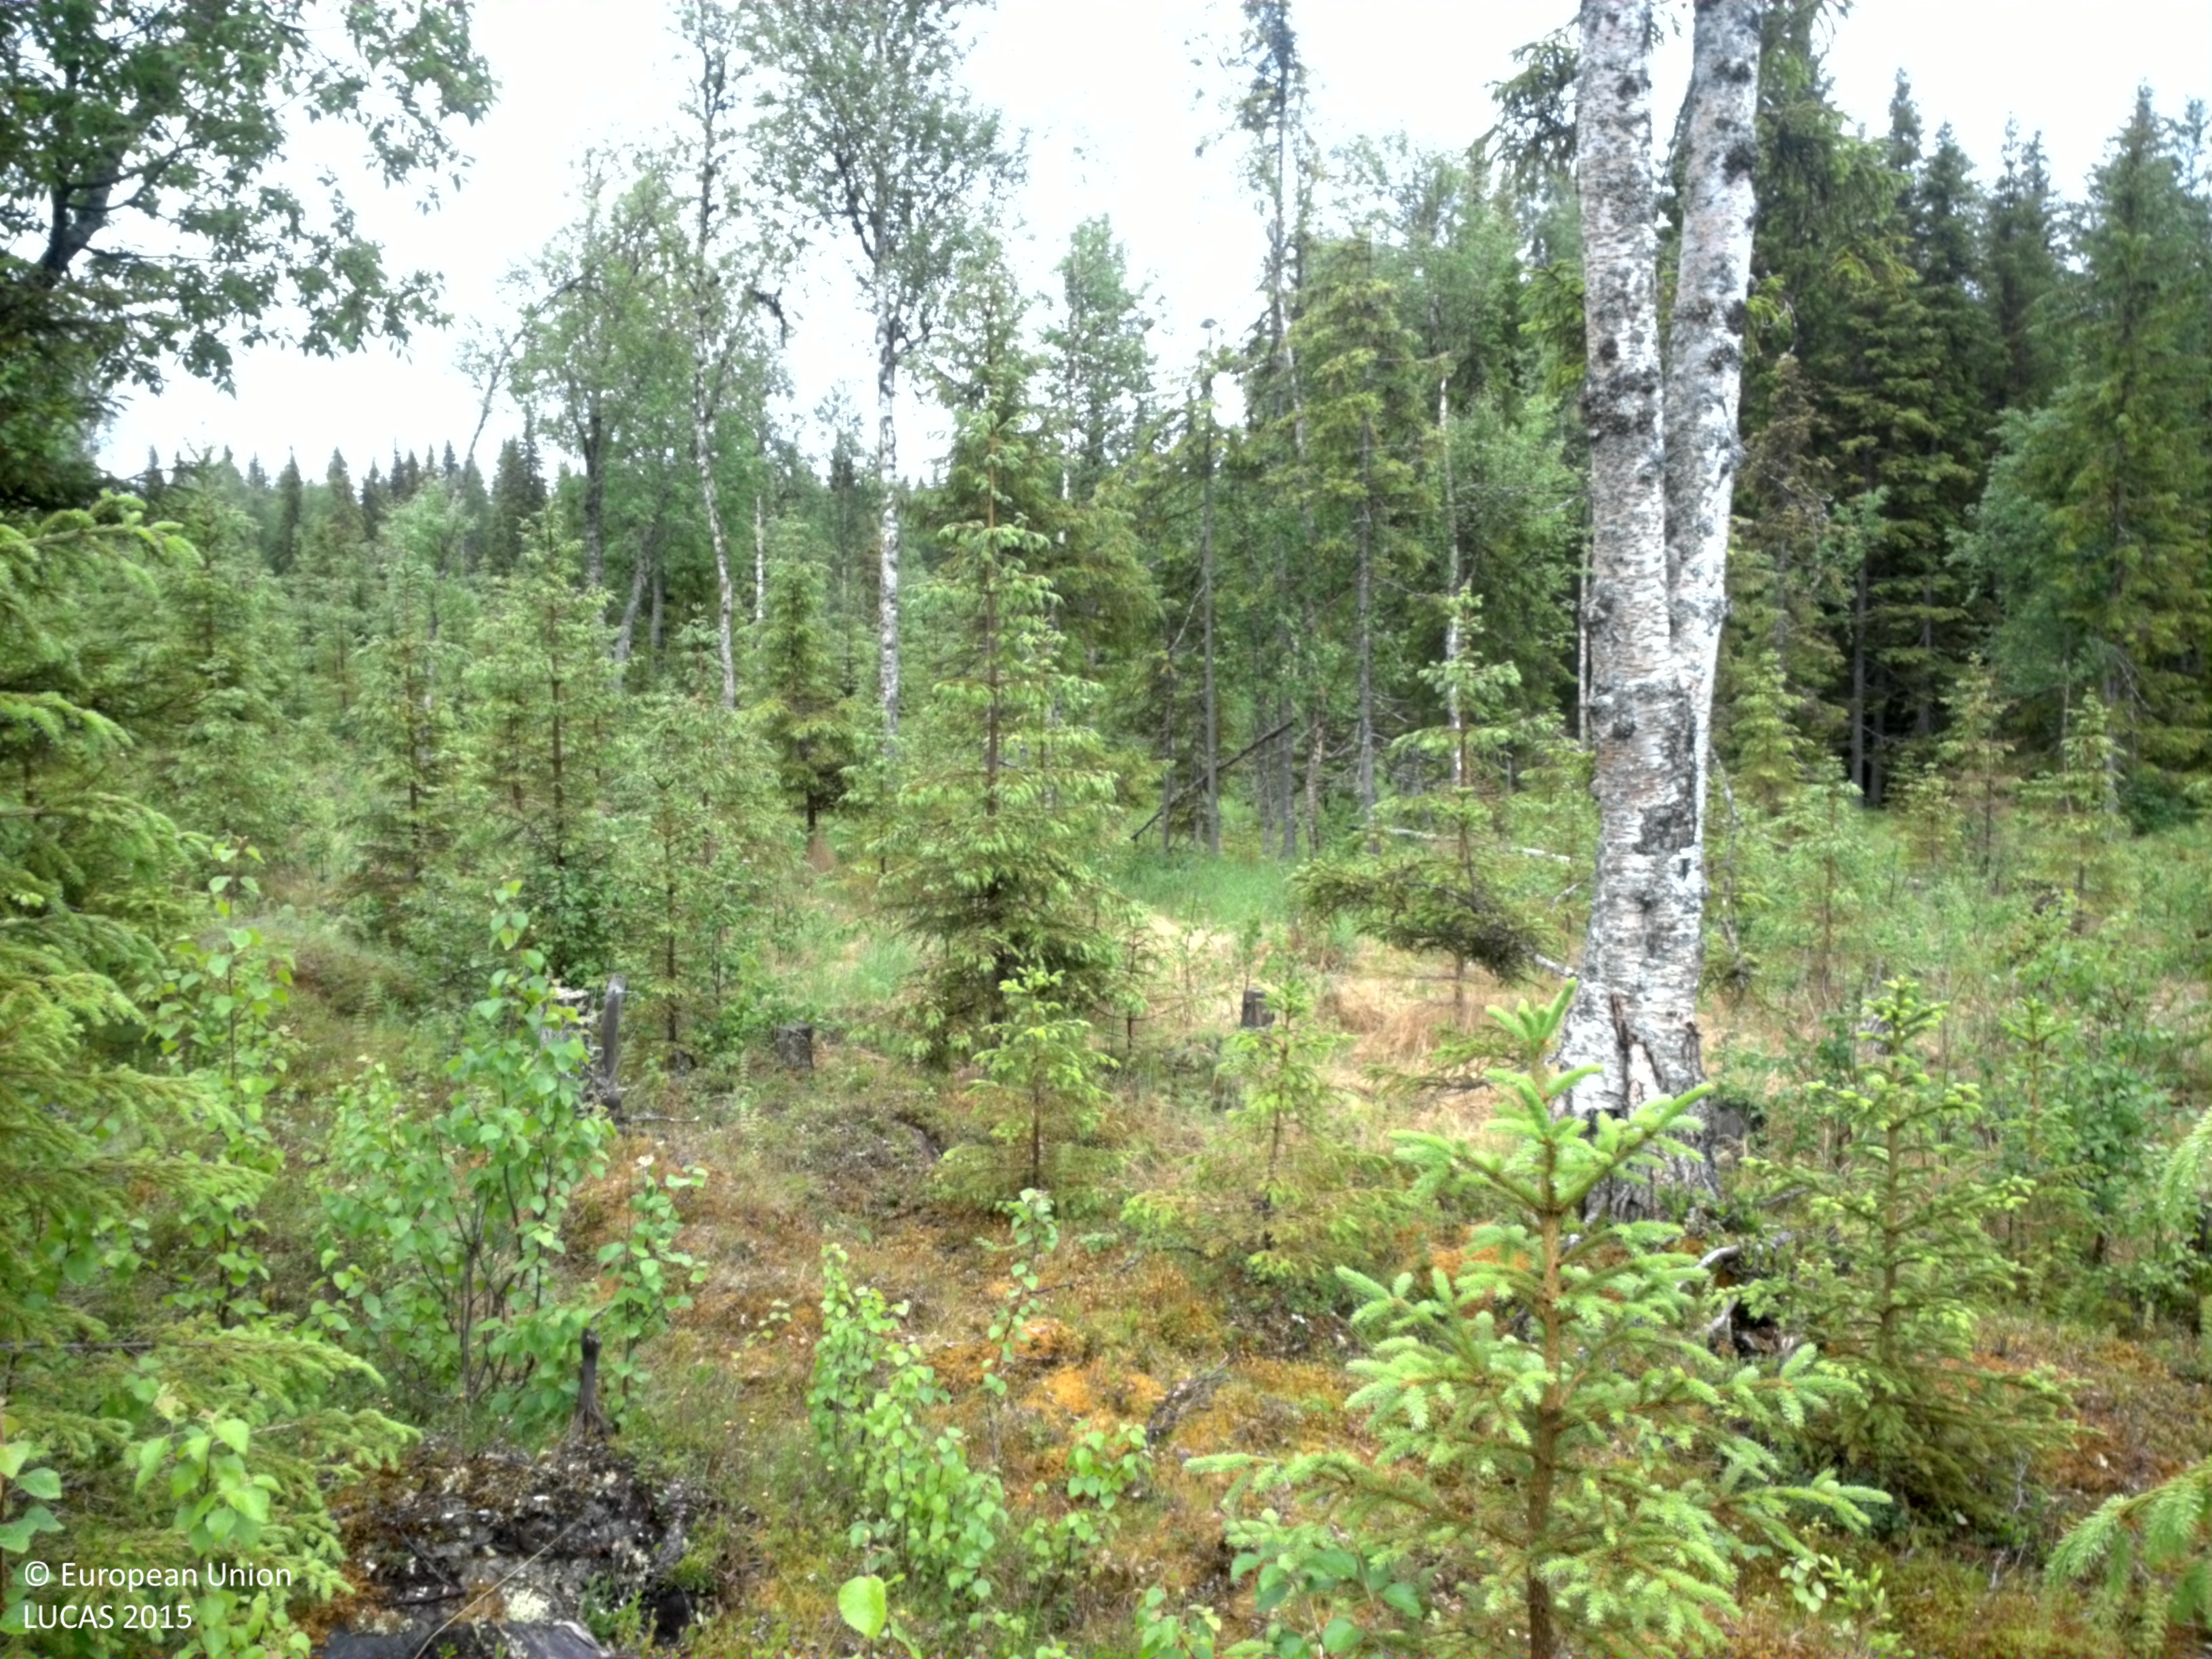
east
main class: Woodland
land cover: Spruce dominated mixed woodland
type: boreal forest
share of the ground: 50 - 75 %
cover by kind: coniferous forest trees 45 %, herbaceous plants 20 %, broadleaved forest trees 15 %, shrubs 15 %, lichens and mosses 5 %
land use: Forestry
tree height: > 5 m
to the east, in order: Spruce dominated mixed woodland; Spruce dominated coniferous woodland; Spruce dominated mixed woodland; Grassland with sparse tree/shrub cover; Spruce dominated mixed woodland
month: July
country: SE
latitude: 64.3573
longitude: 18.3985
